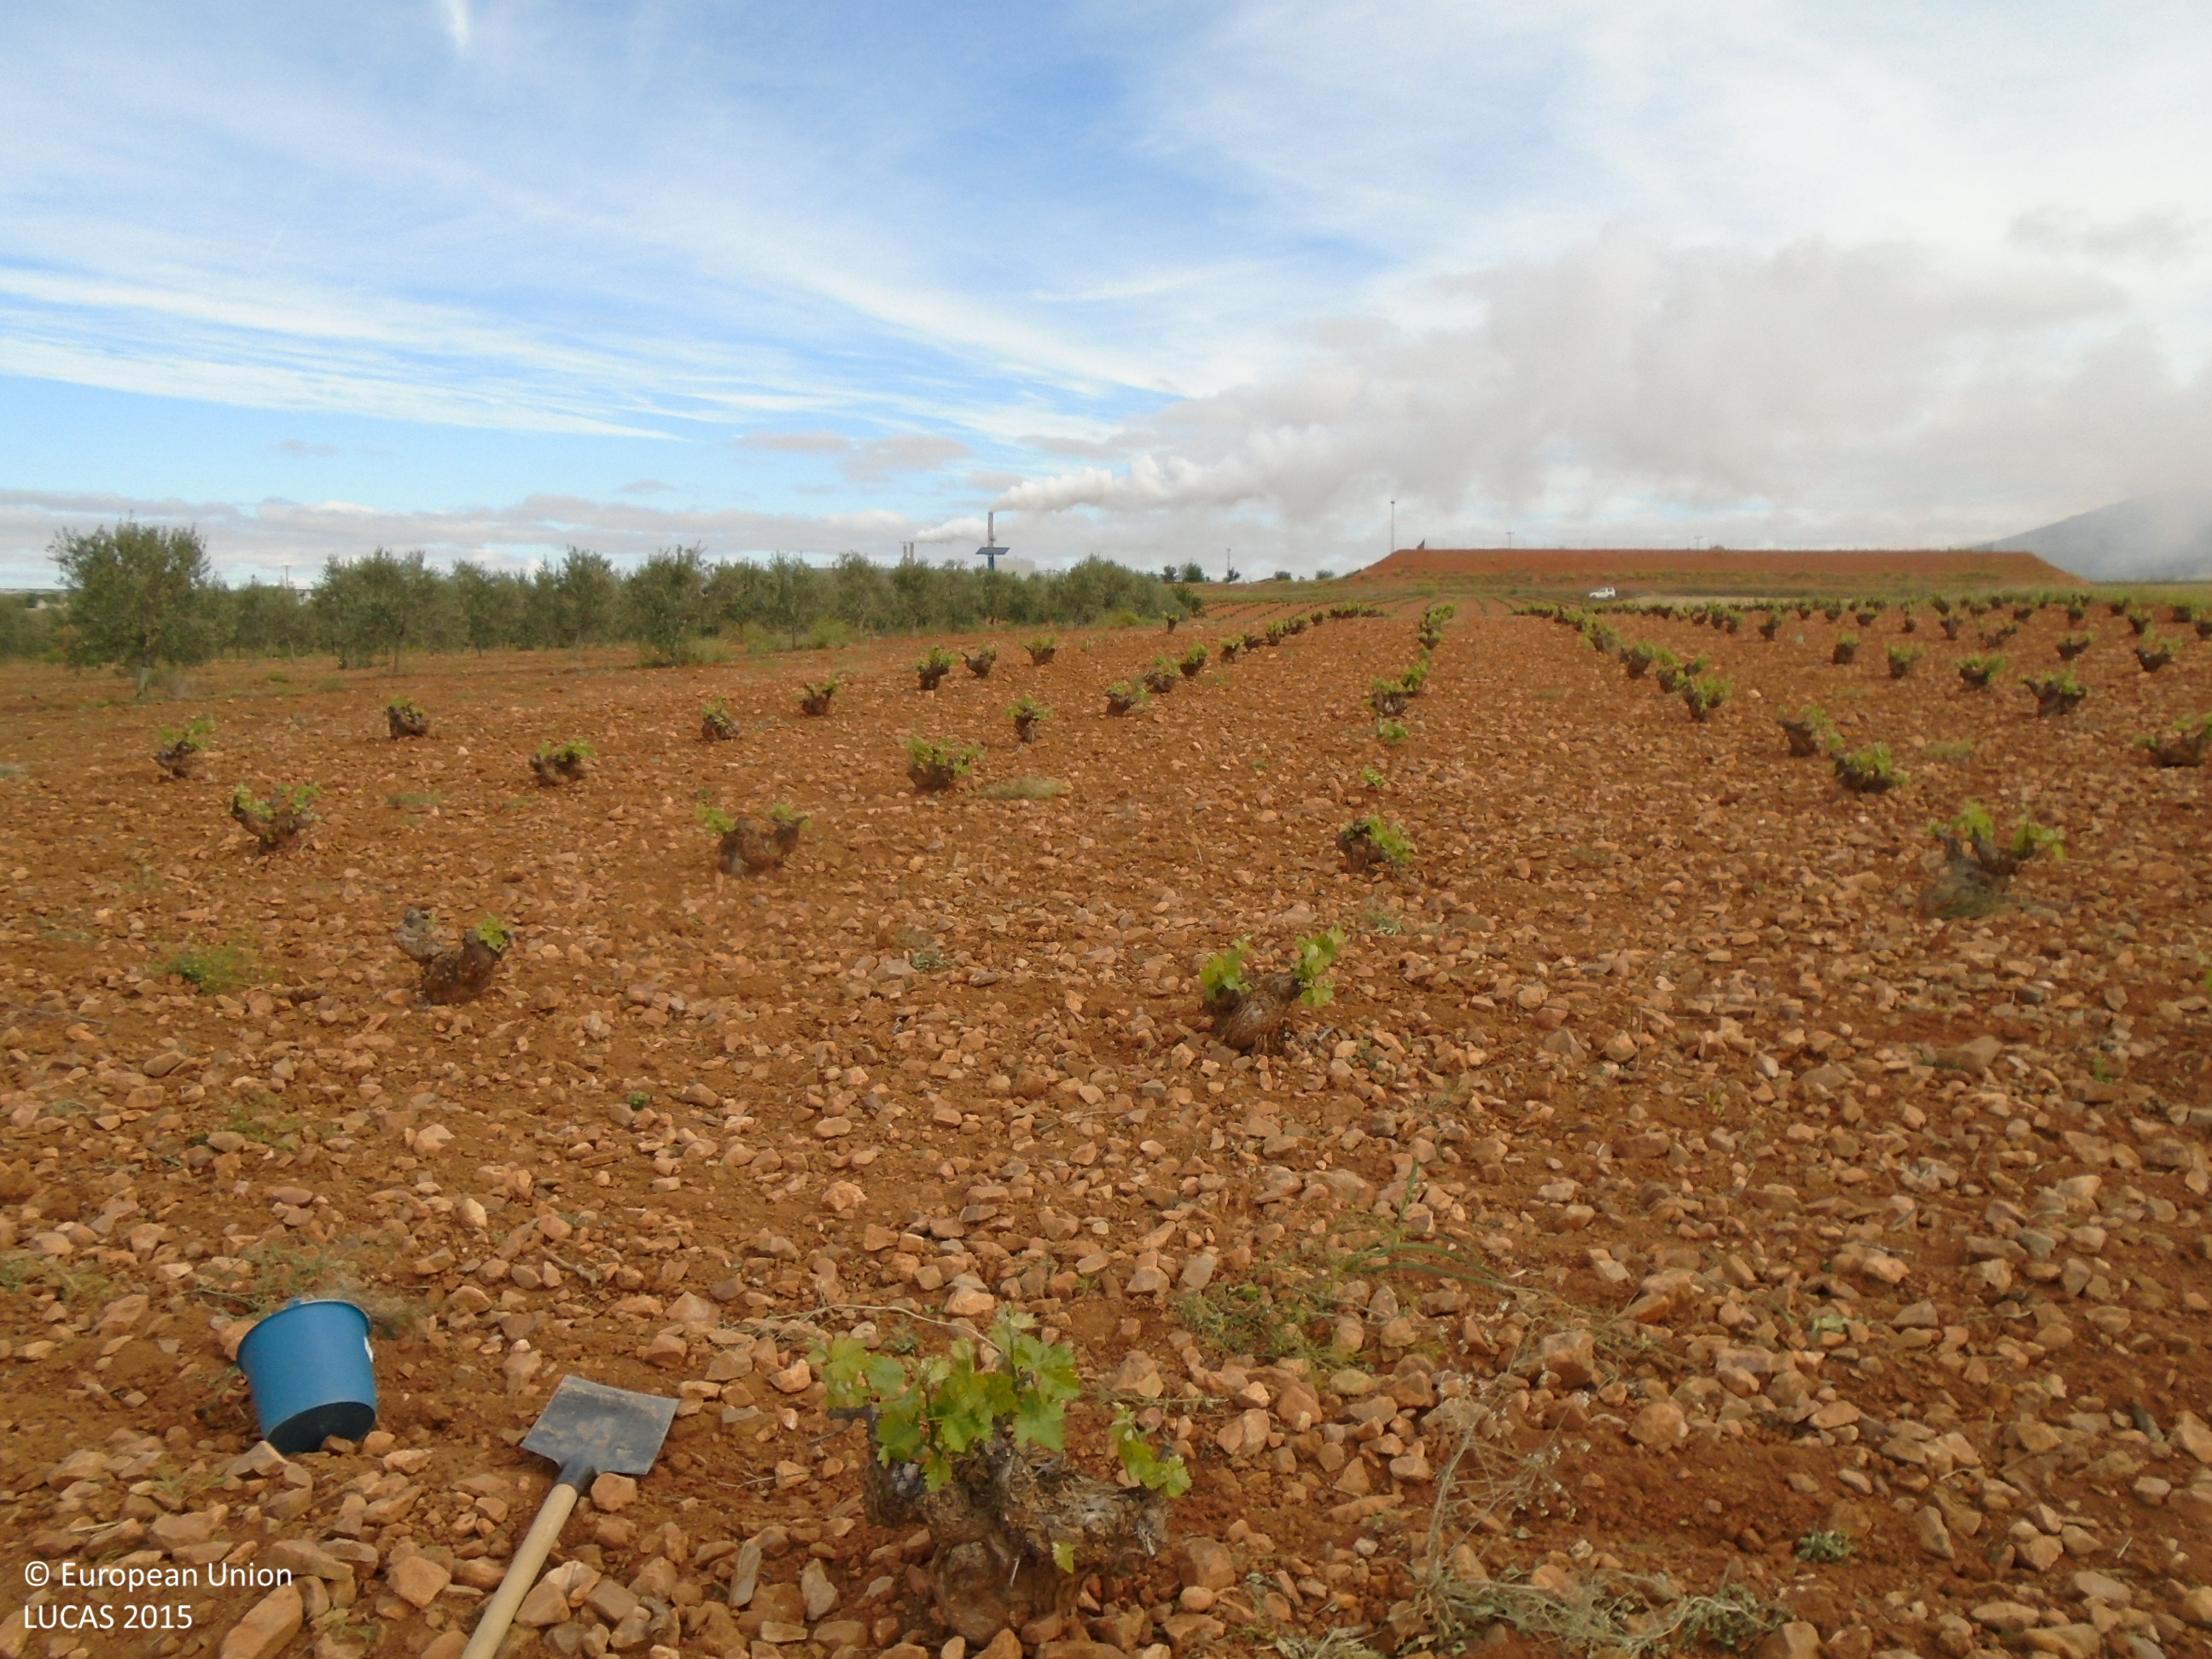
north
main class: Cropland
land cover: Vineyards
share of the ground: 10 - 25 %
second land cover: Other bare soil
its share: > 75 %
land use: Agriculture (excluding fallow land and kitchen gardens)
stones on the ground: > 50 %
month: May
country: ES
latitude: 39.6788
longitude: -3.7507
